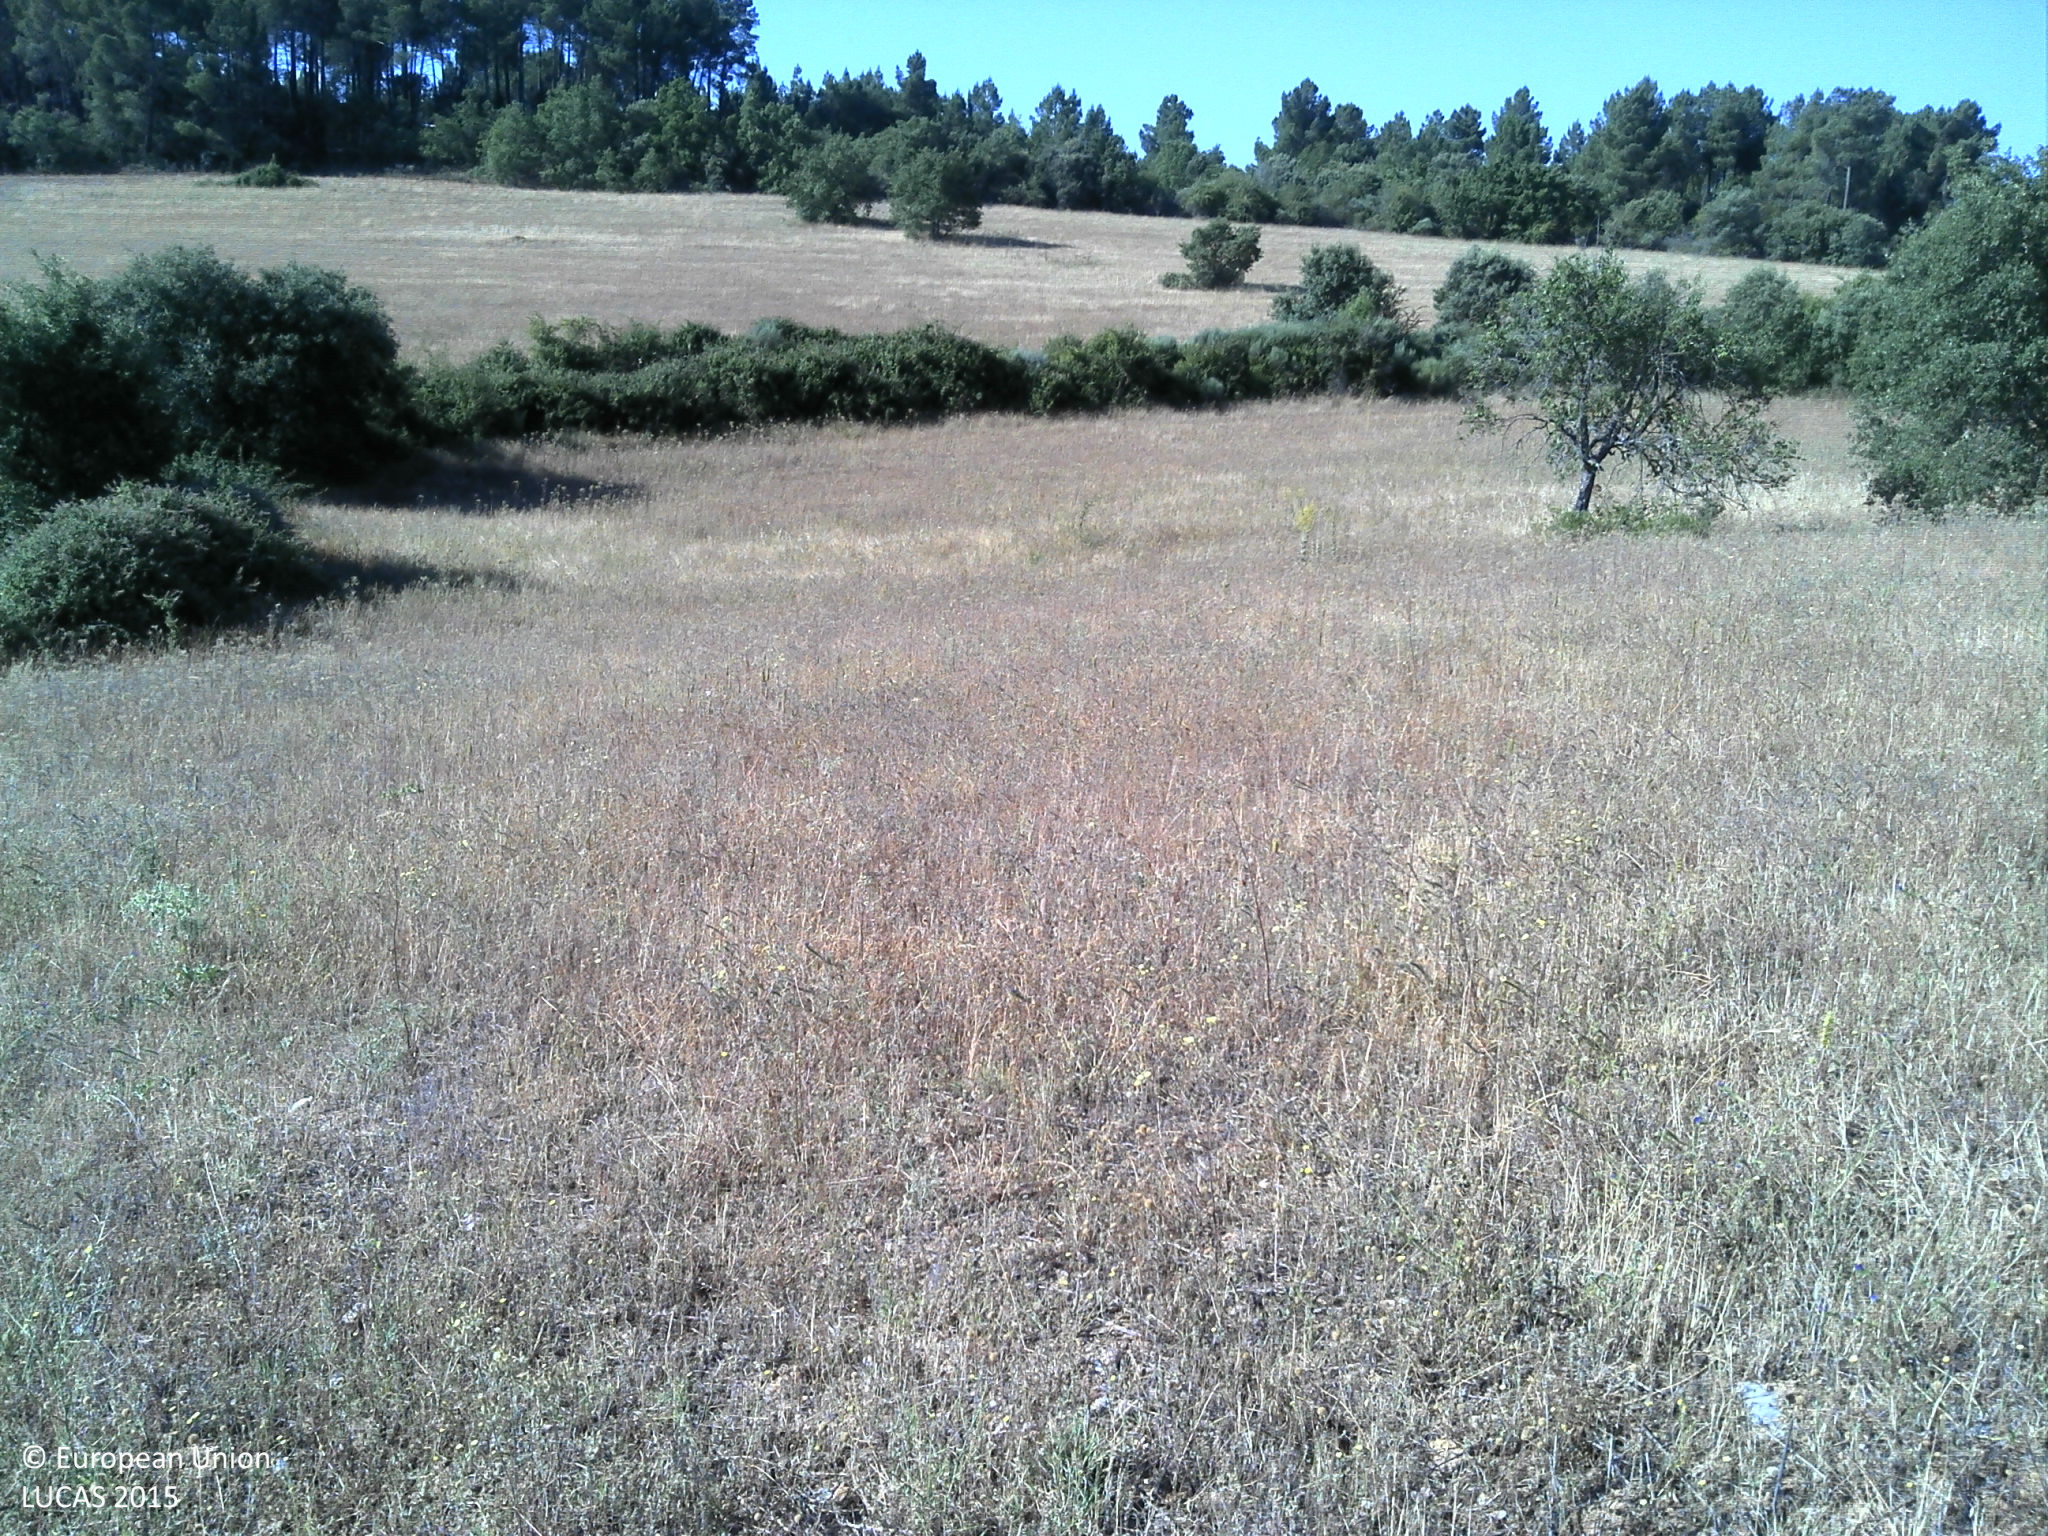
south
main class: Grassland
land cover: Spontaneously vegetated surfaces
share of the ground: > 75 %
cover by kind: herbaceous plants 95 %, unconsolidated bare surface 5 %
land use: Fallow land
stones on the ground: 10 - 25 %
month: June
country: PT
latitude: 40.8772
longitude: -6.8692
